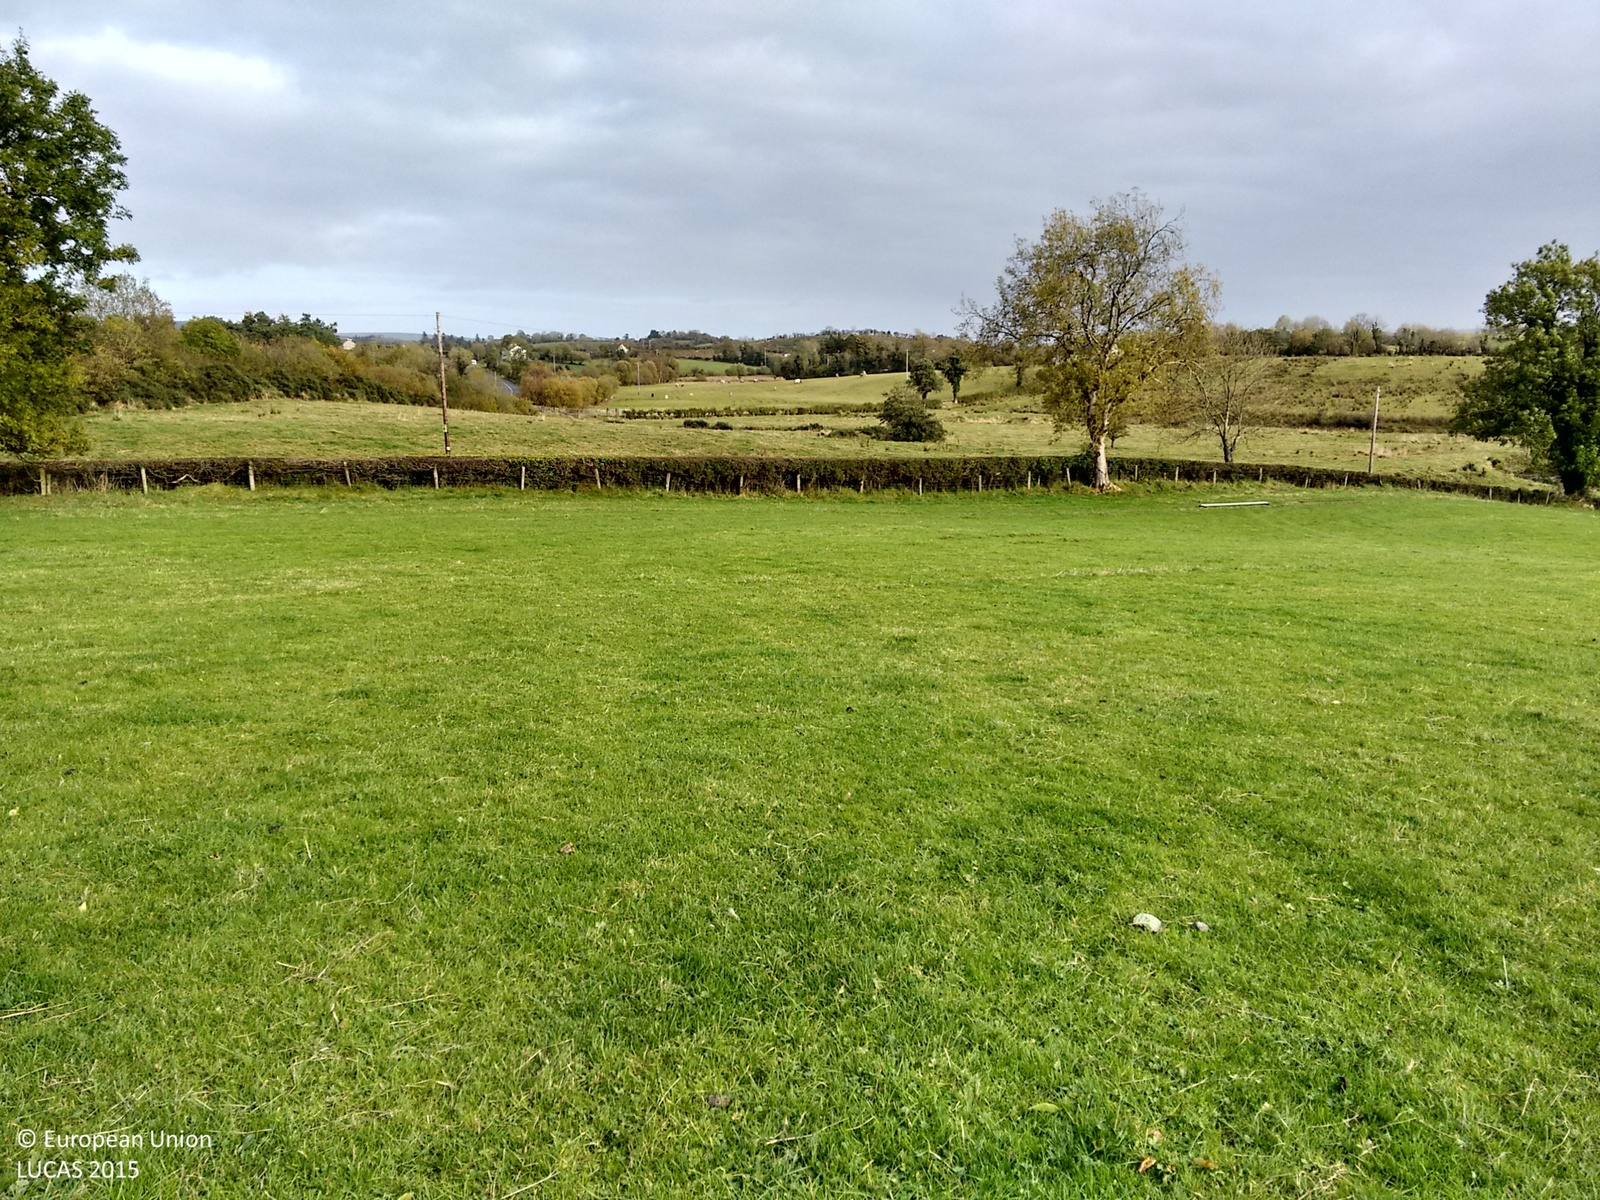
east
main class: Grassland
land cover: Grassland without tree/shrub cover
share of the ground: > 75 %
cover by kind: herbaceous plants 100 %
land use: Agriculture (excluding fallow land and kitchen gardens)
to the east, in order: Grassland without tree/shrub cover; Single bushes/trees; Fences; Managed hedges; Ditches and canals; Grass margins; Paved roads, cycling and walking lanes; Grass margins; Managed hedges; Electric lines; Grassland without tree/shrub cover; Inland fresh running water; Grassland without tree/shrub cover
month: October
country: GB
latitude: 54.3919
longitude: -7.4176
